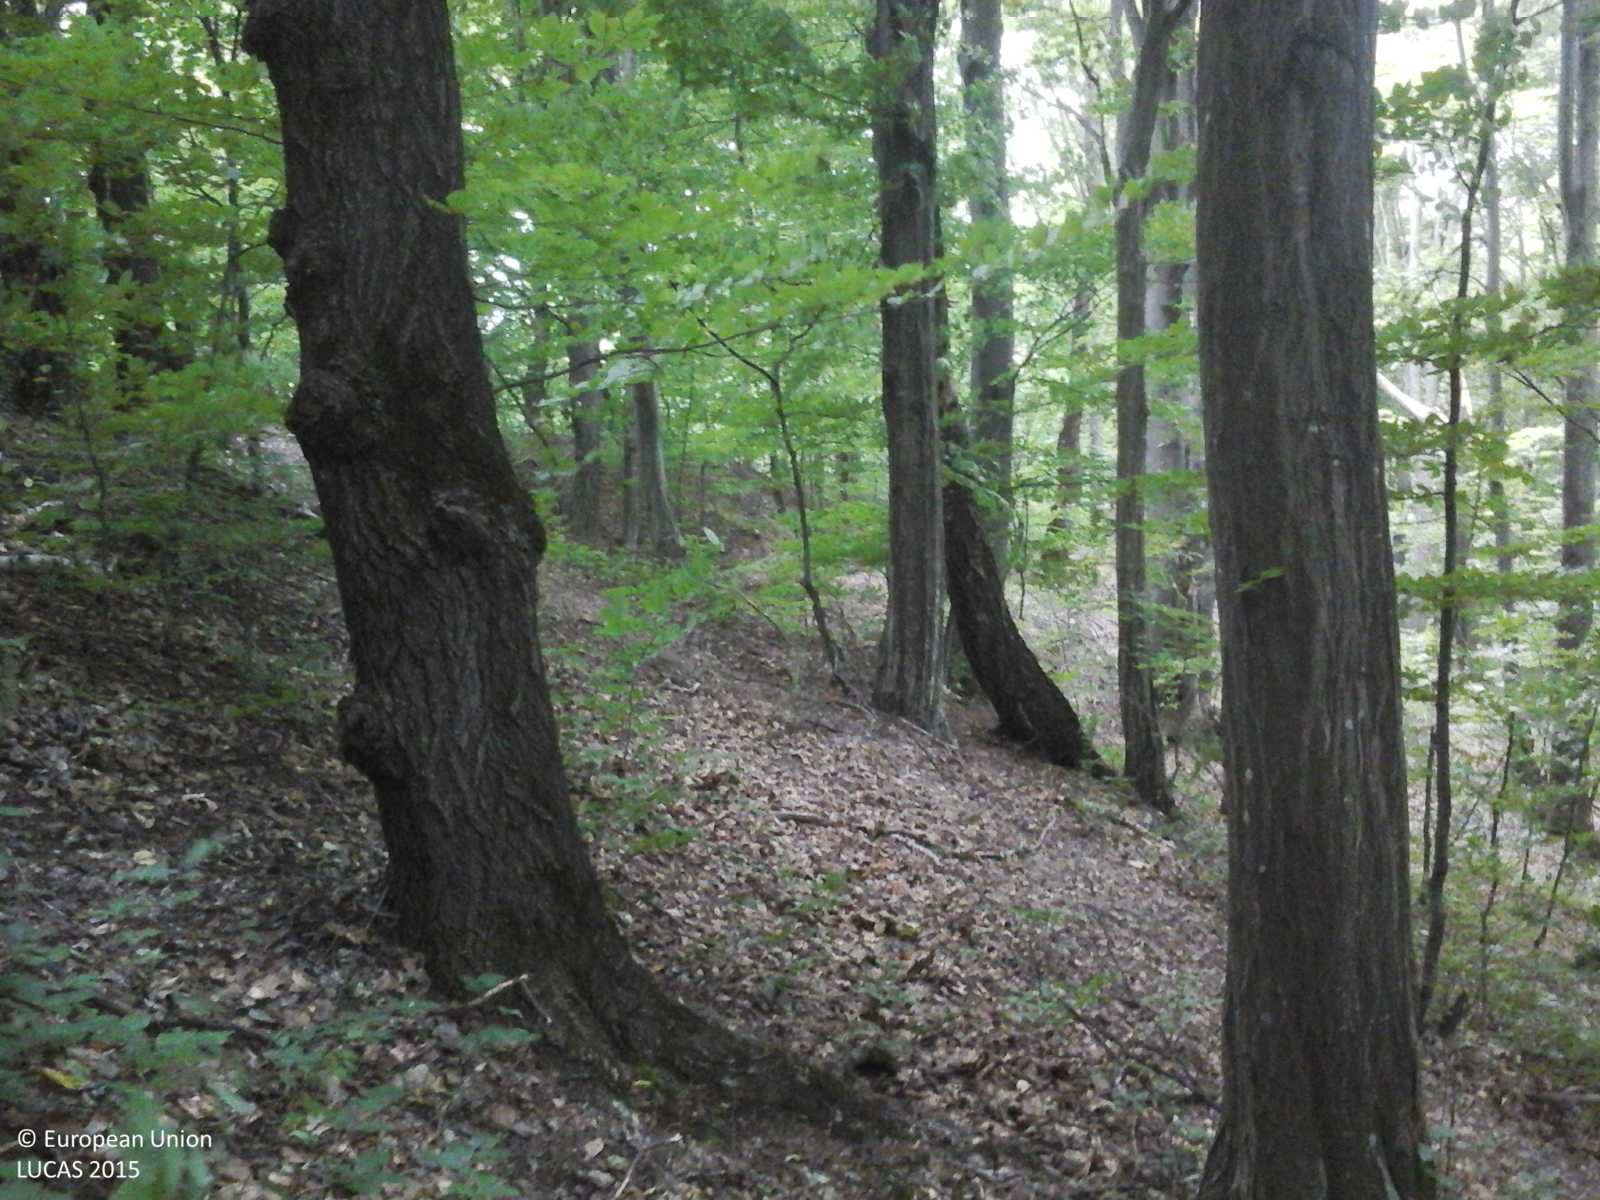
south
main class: Woodland
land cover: Broadleaved woodland
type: beech forest
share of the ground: > 75 %
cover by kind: broadleaved forest trees 100 %
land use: Forestry
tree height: > 5 m
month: June
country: RO
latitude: 46.6161
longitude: 26.5236
